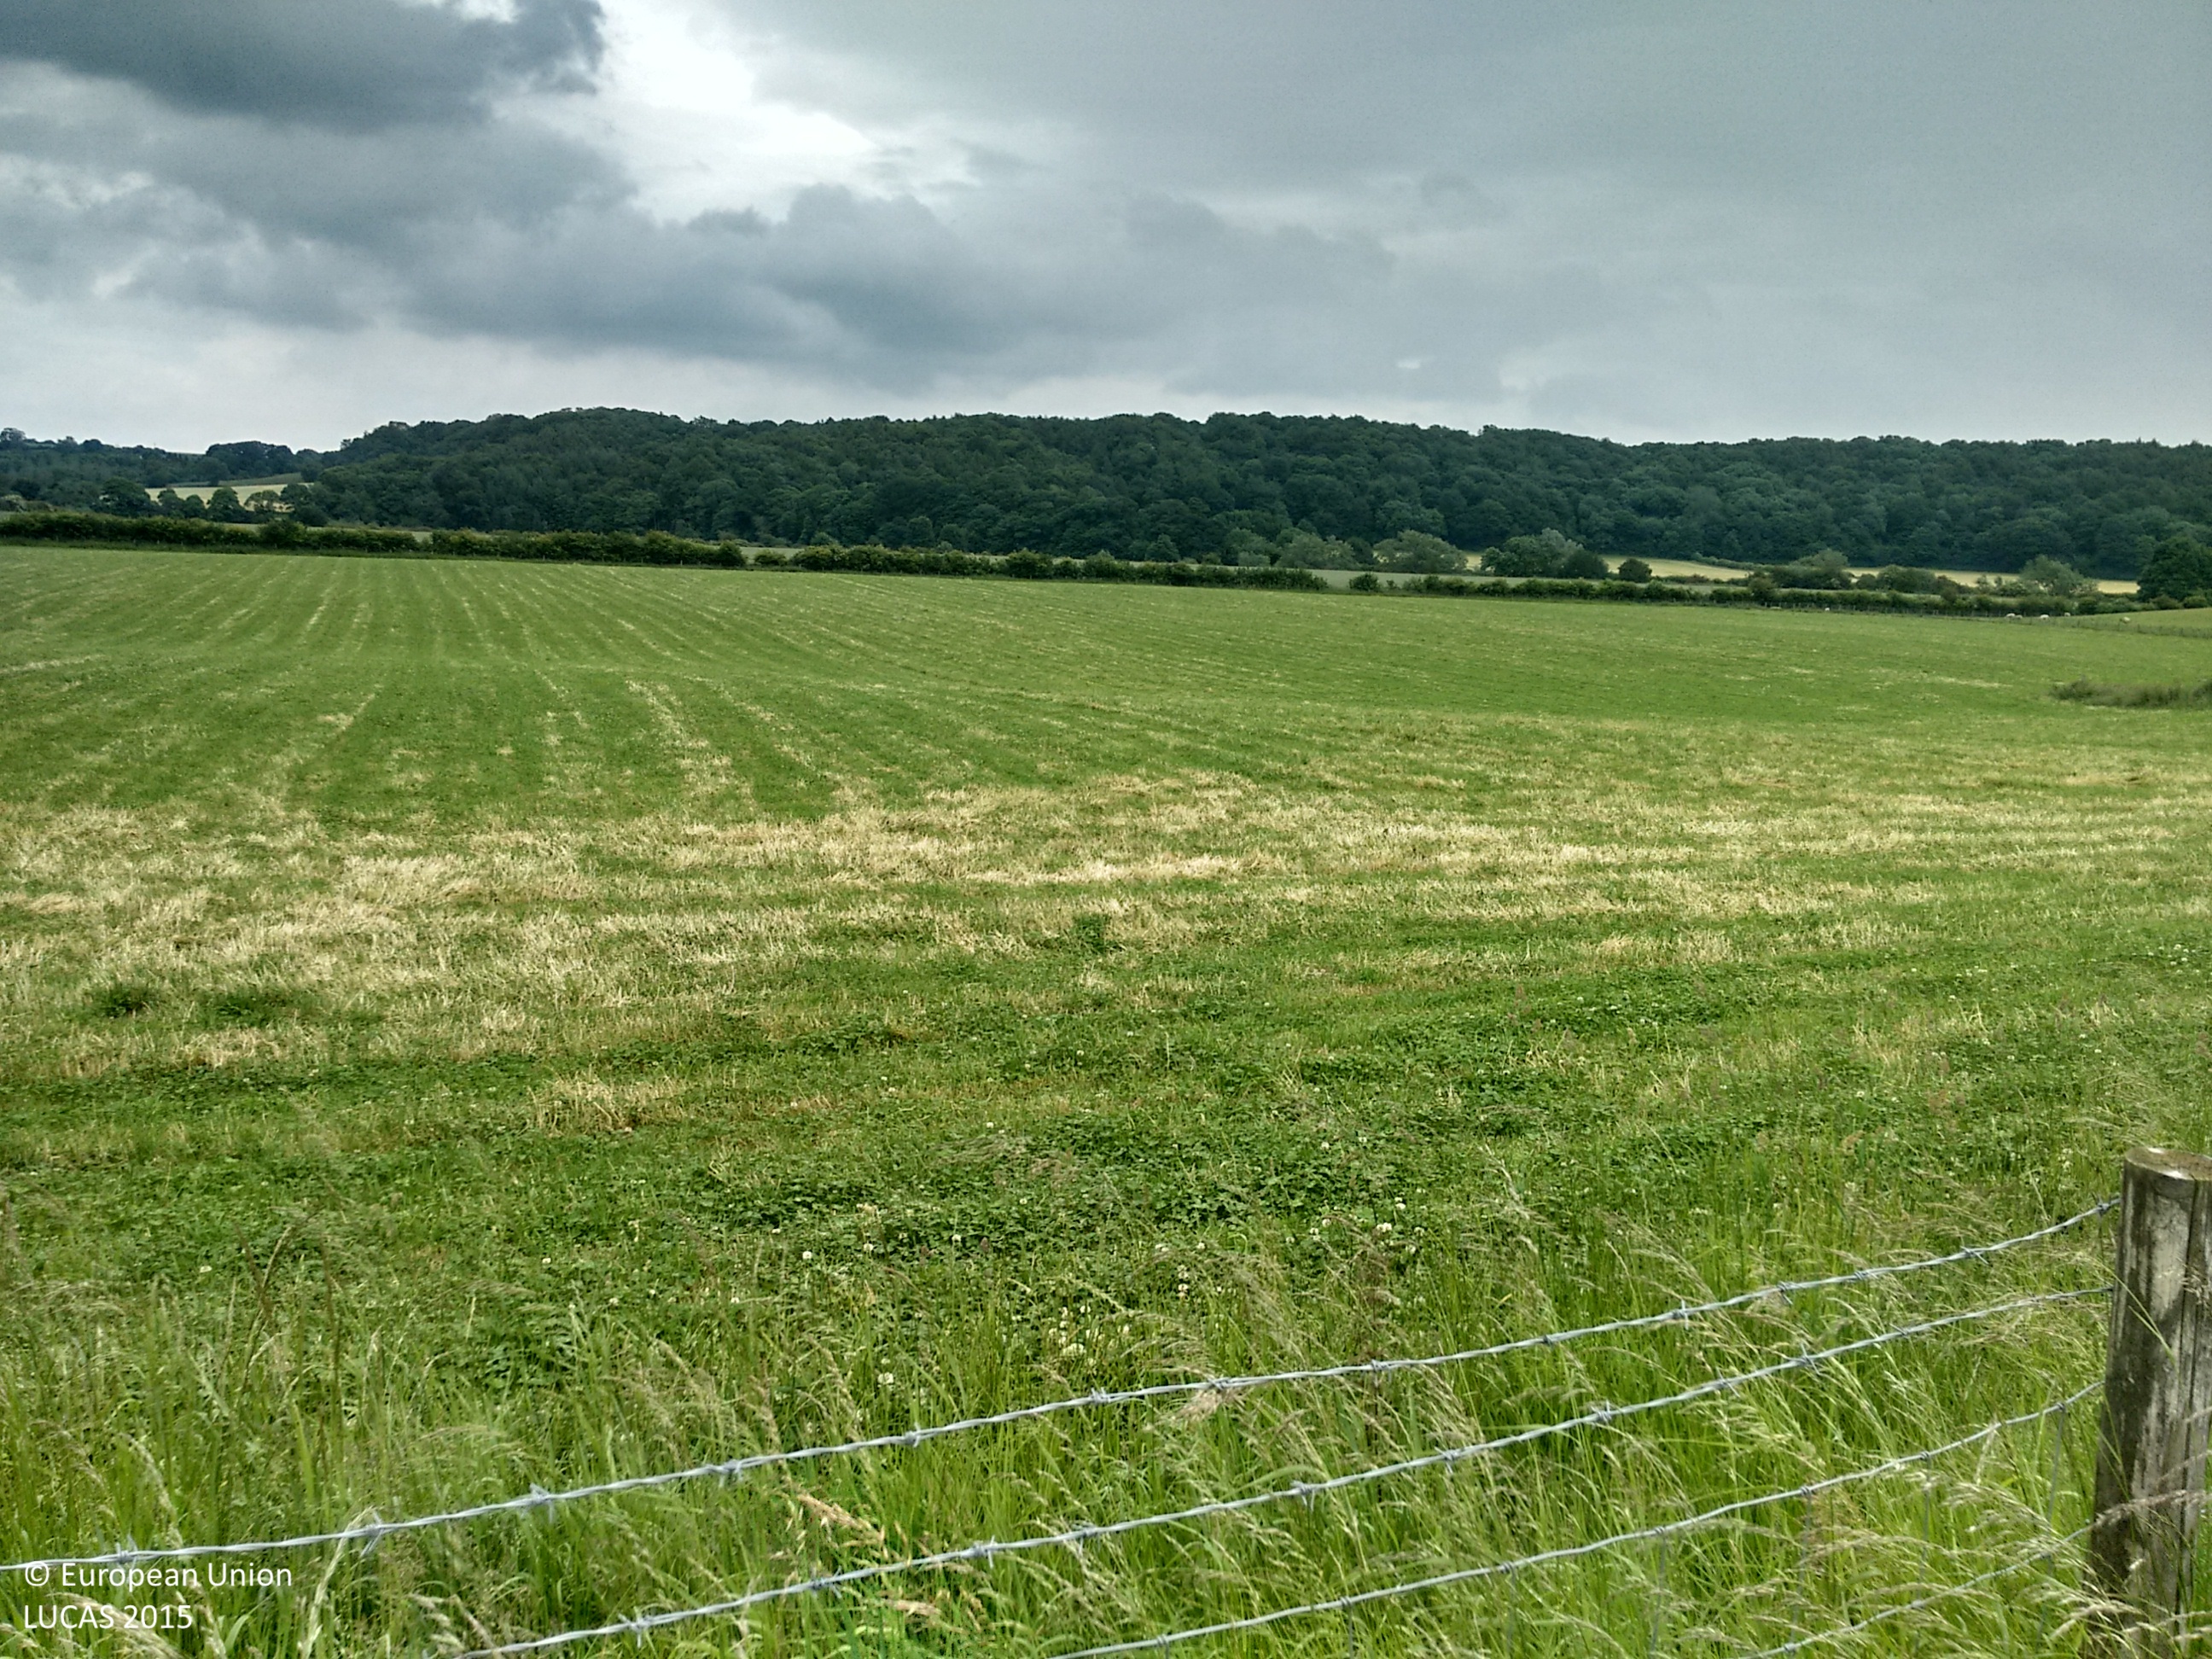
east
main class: Grassland
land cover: Grassland without tree/shrub cover
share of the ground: > 75 %
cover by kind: herbaceous plants 100 %
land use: Agriculture (excluding fallow land and kitchen gardens)
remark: Harvested field
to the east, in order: Grassland without tree/shrub cover; Fences; Managed hedges; Grassland without tree/shrub cover
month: June
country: GB
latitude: 54.7541
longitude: -1.5624
